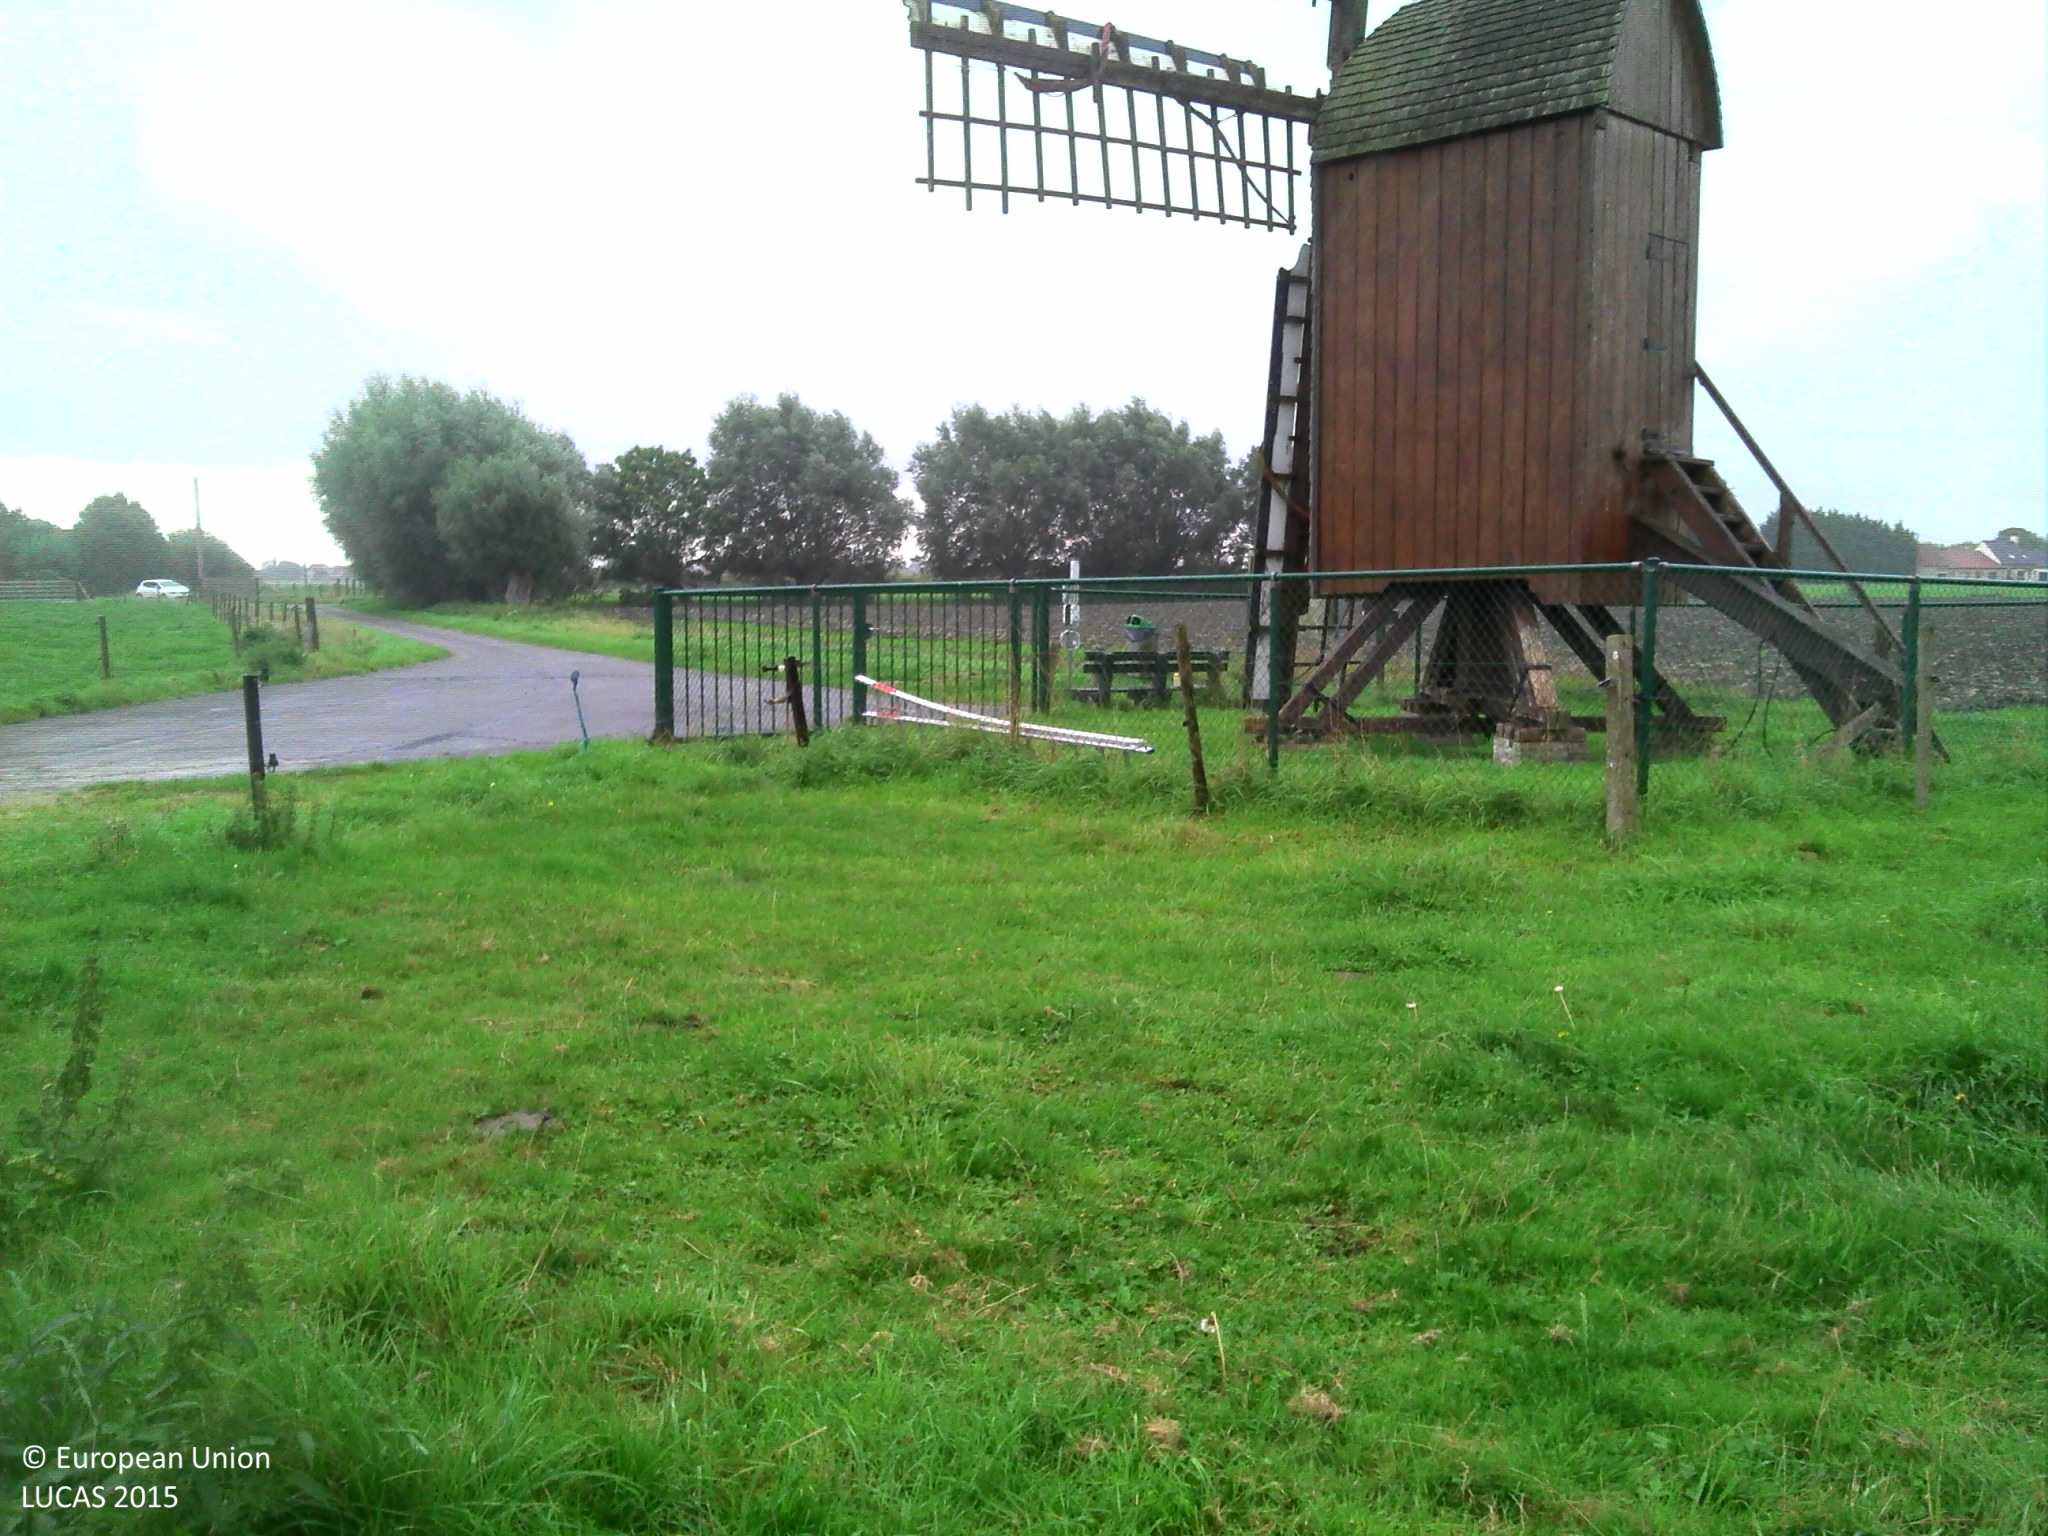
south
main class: Grassland
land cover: Grassland without tree/shrub cover
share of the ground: > 75 %
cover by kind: herbaceous plants 100 %
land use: Agriculture (excluding fallow land and kitchen gardens)
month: September
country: BE
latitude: 51.0532
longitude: 2.7270
